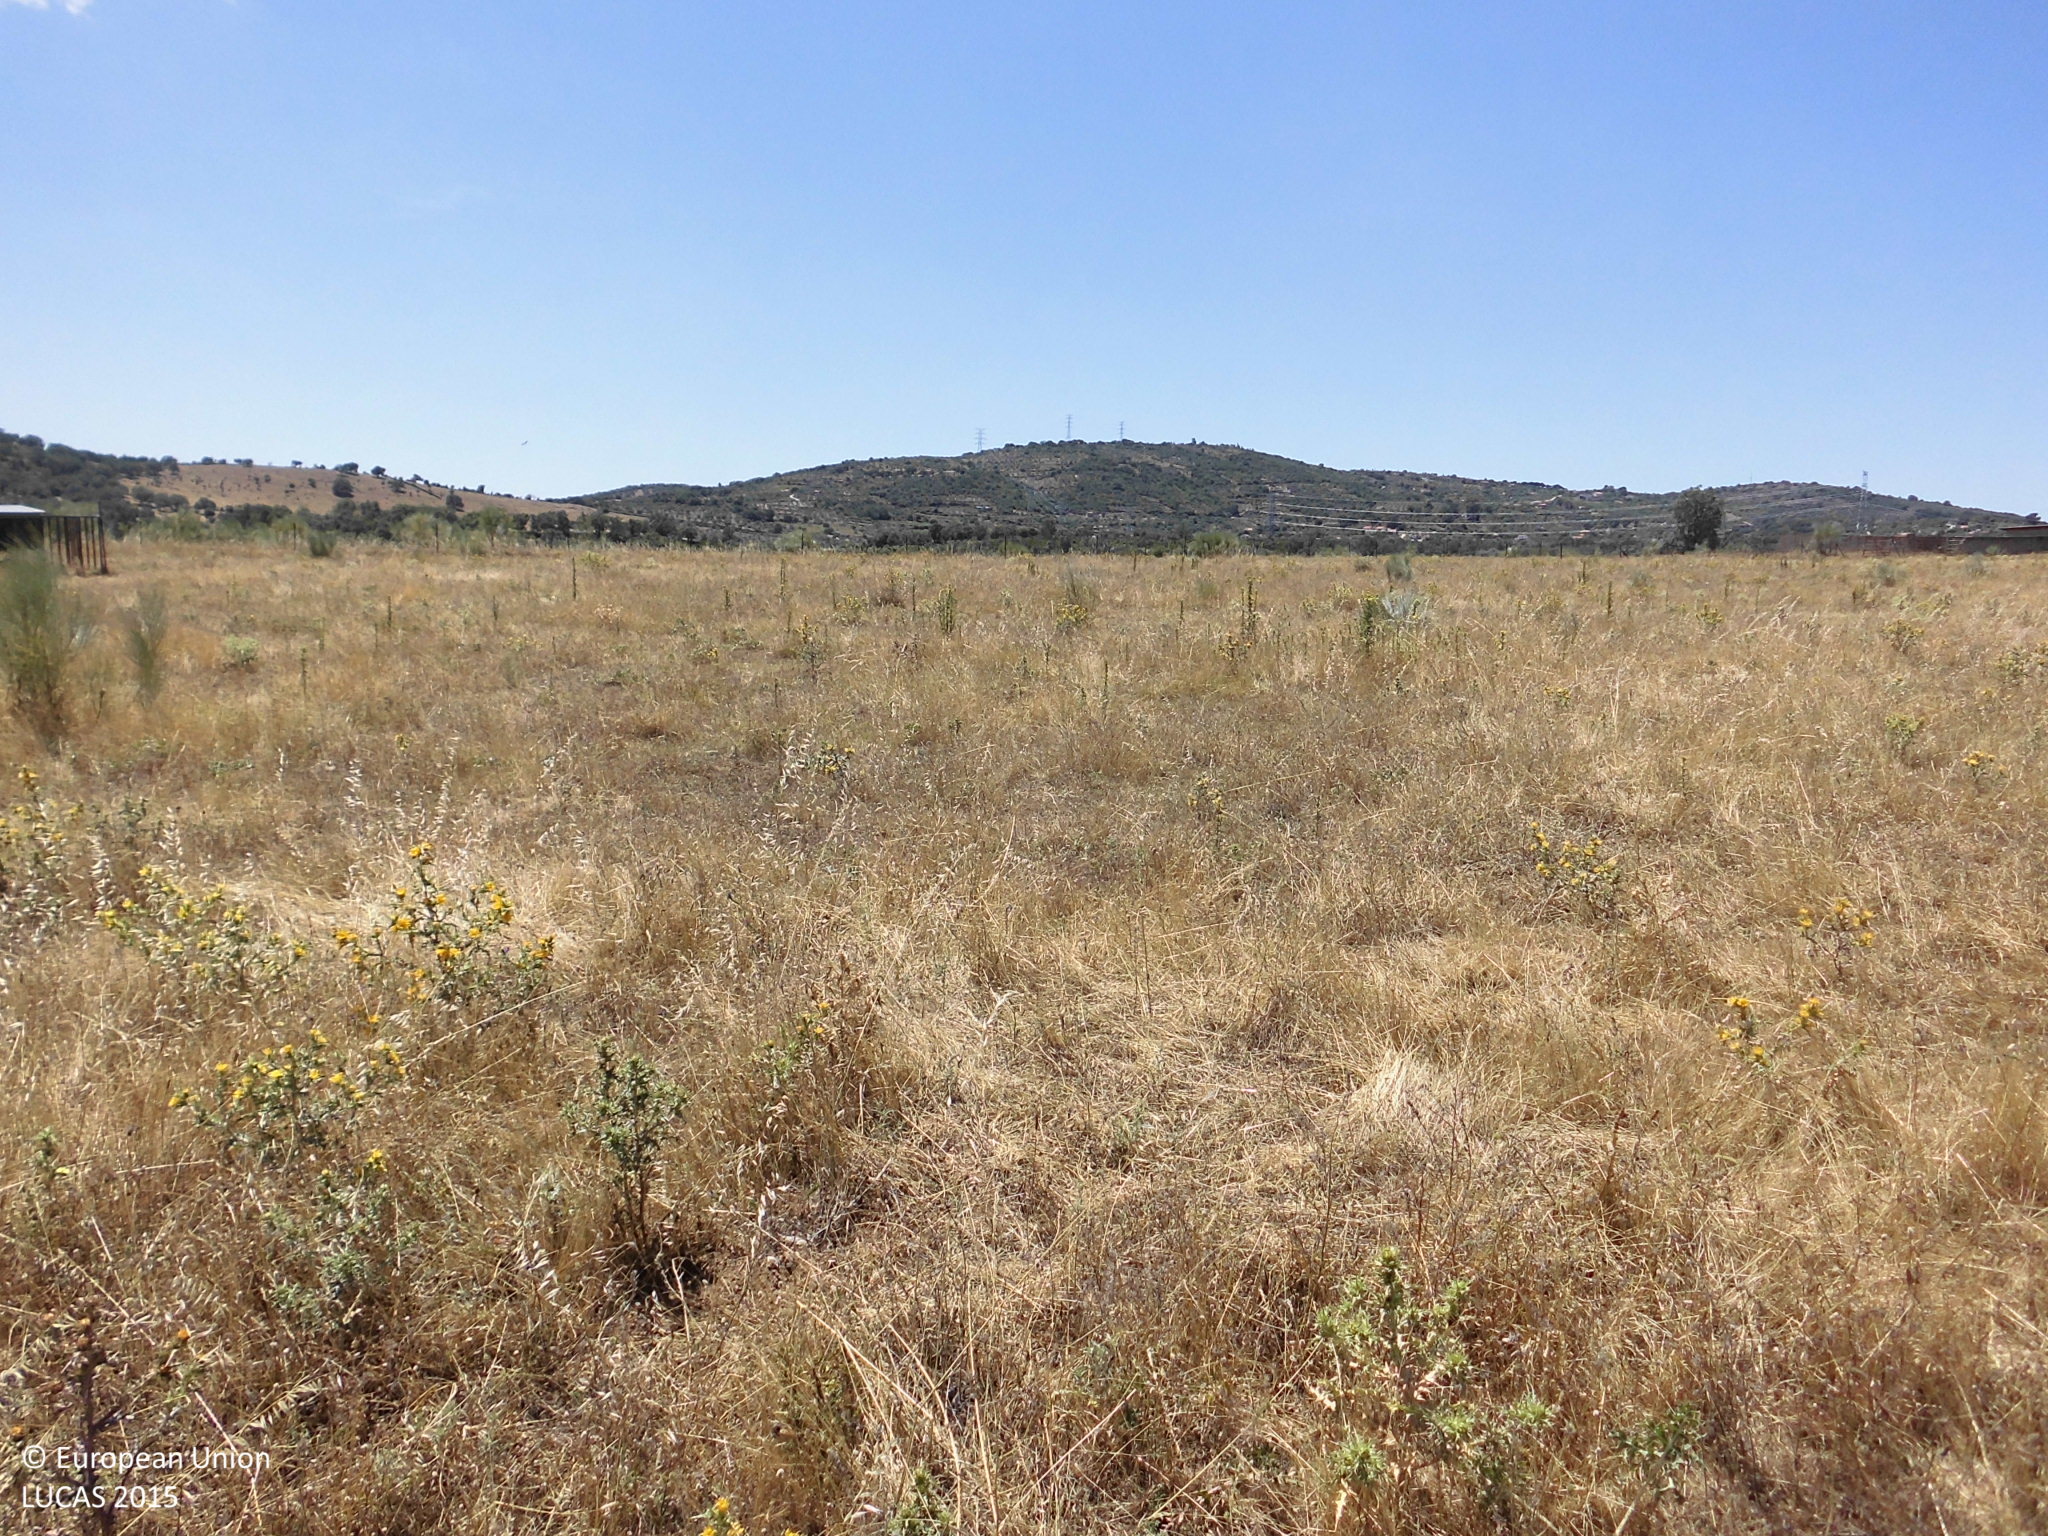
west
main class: Grassland
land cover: Grassland without tree/shrub cover
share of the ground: > 75 %
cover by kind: herbaceous plants 100 %
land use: Agriculture (excluding fallow land and kitchen gardens)
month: June
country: ES
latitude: 40.0096
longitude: -6.0136
